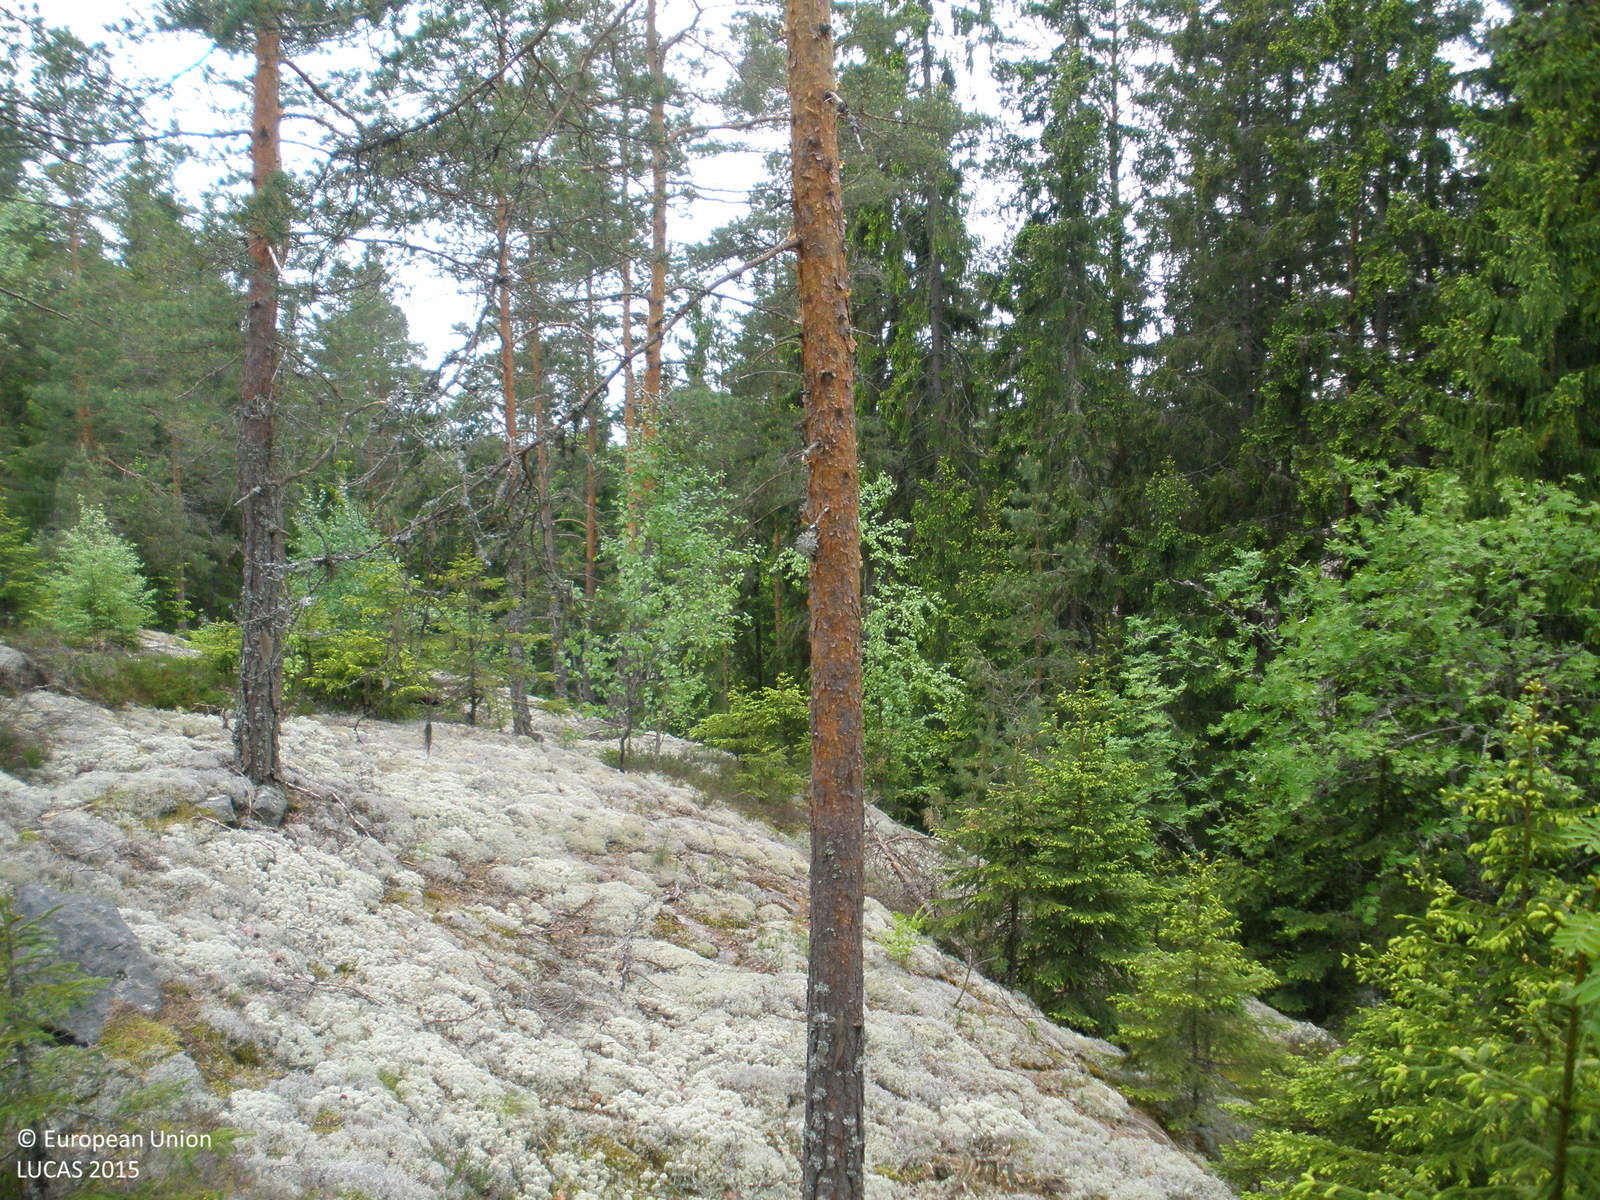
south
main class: Woodland
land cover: Pine dominated coniferous woodland
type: boreal forest
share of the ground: 50 - 75 %
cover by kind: coniferous forest trees 60 %, lichens and mosses 20 %, consolidated bare surface 10 %, broadleaved forest trees 5 %, shrubs 5 %
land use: Forestry
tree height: > 5 m
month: June
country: FI
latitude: 60.5556
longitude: 23.0818
